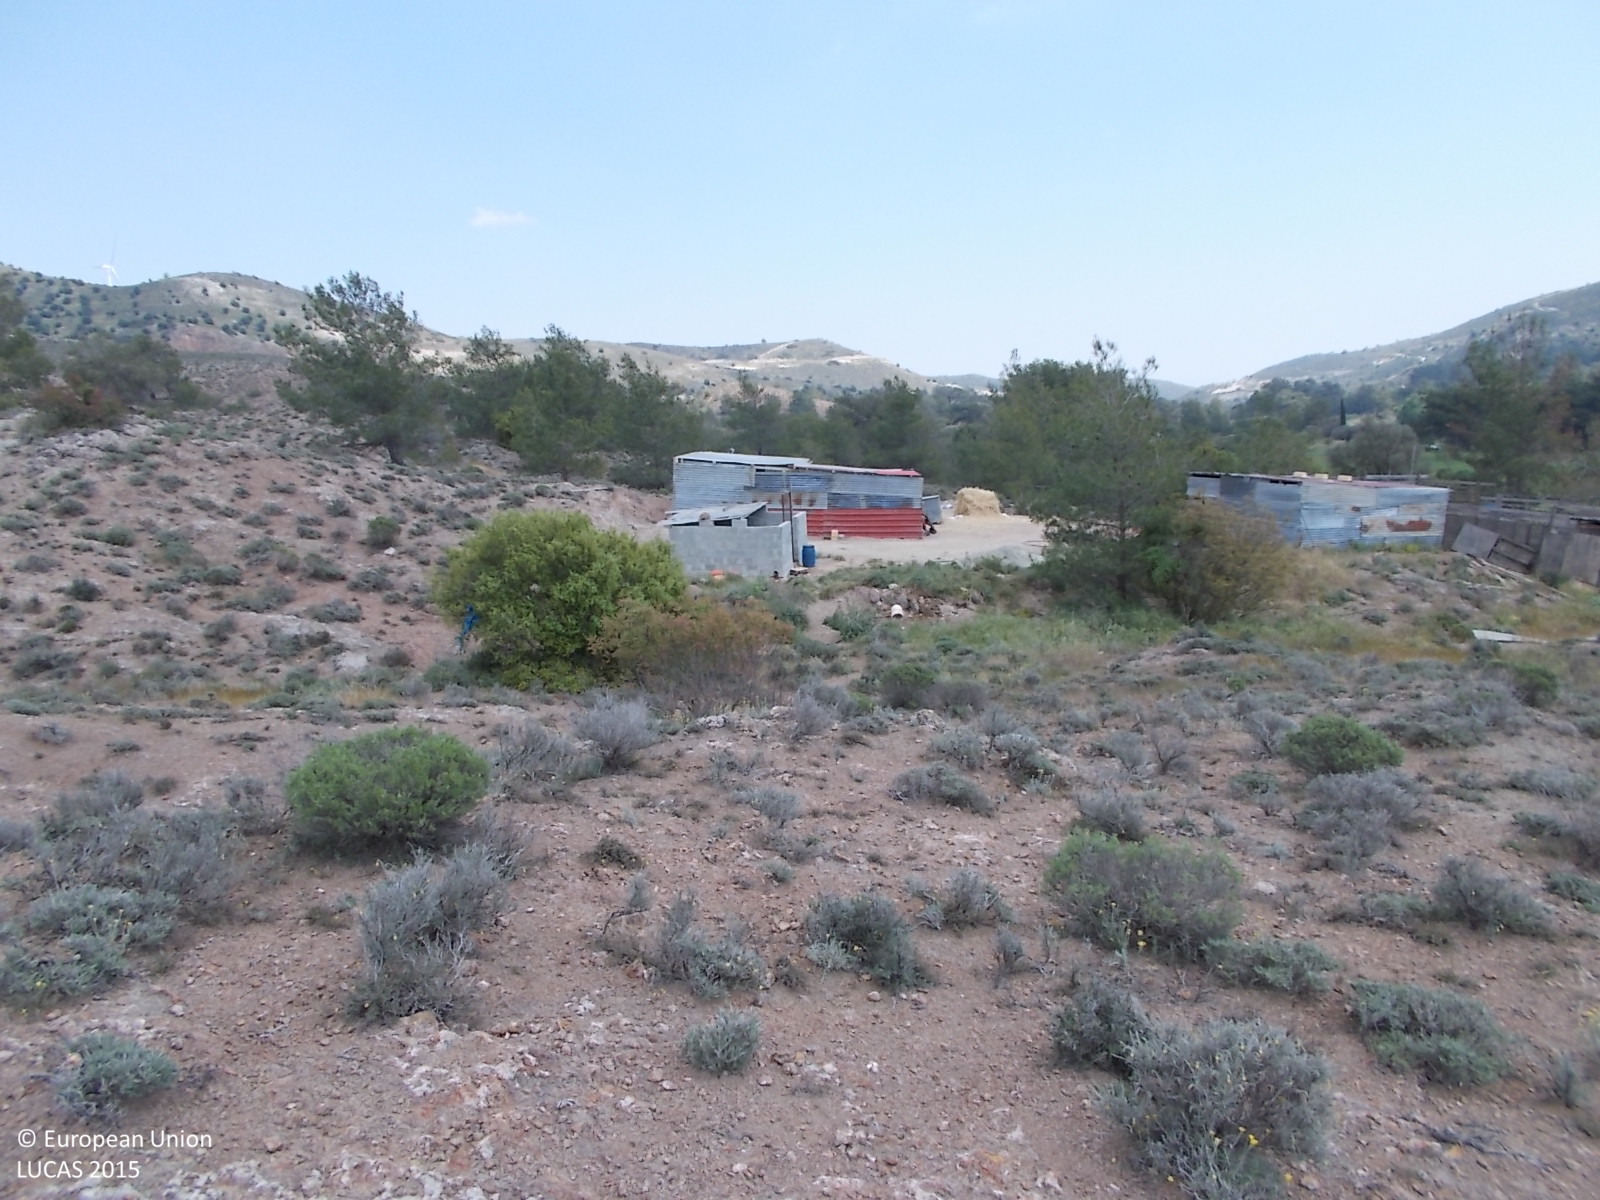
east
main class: Shrubland
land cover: Shrubland without tree cover
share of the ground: 25 - 50 %
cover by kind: unconsolidated bare surface 50 %, shrubs 45 %, consolidated bare surface 5 %
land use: Semi-natural and natural areas not in use
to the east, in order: Shrubland without tree cover; Shrubland with sparse tree cover; Artificial constructions in urban areas; Pine dominated coniferous woodland; Tracks; Pine dominated coniferous woodland; Rivers and streams; Pine dominated coniferous woodland; Spontaneously vegetated surfaces
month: April
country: CY
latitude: 34.9217
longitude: 33.4502
